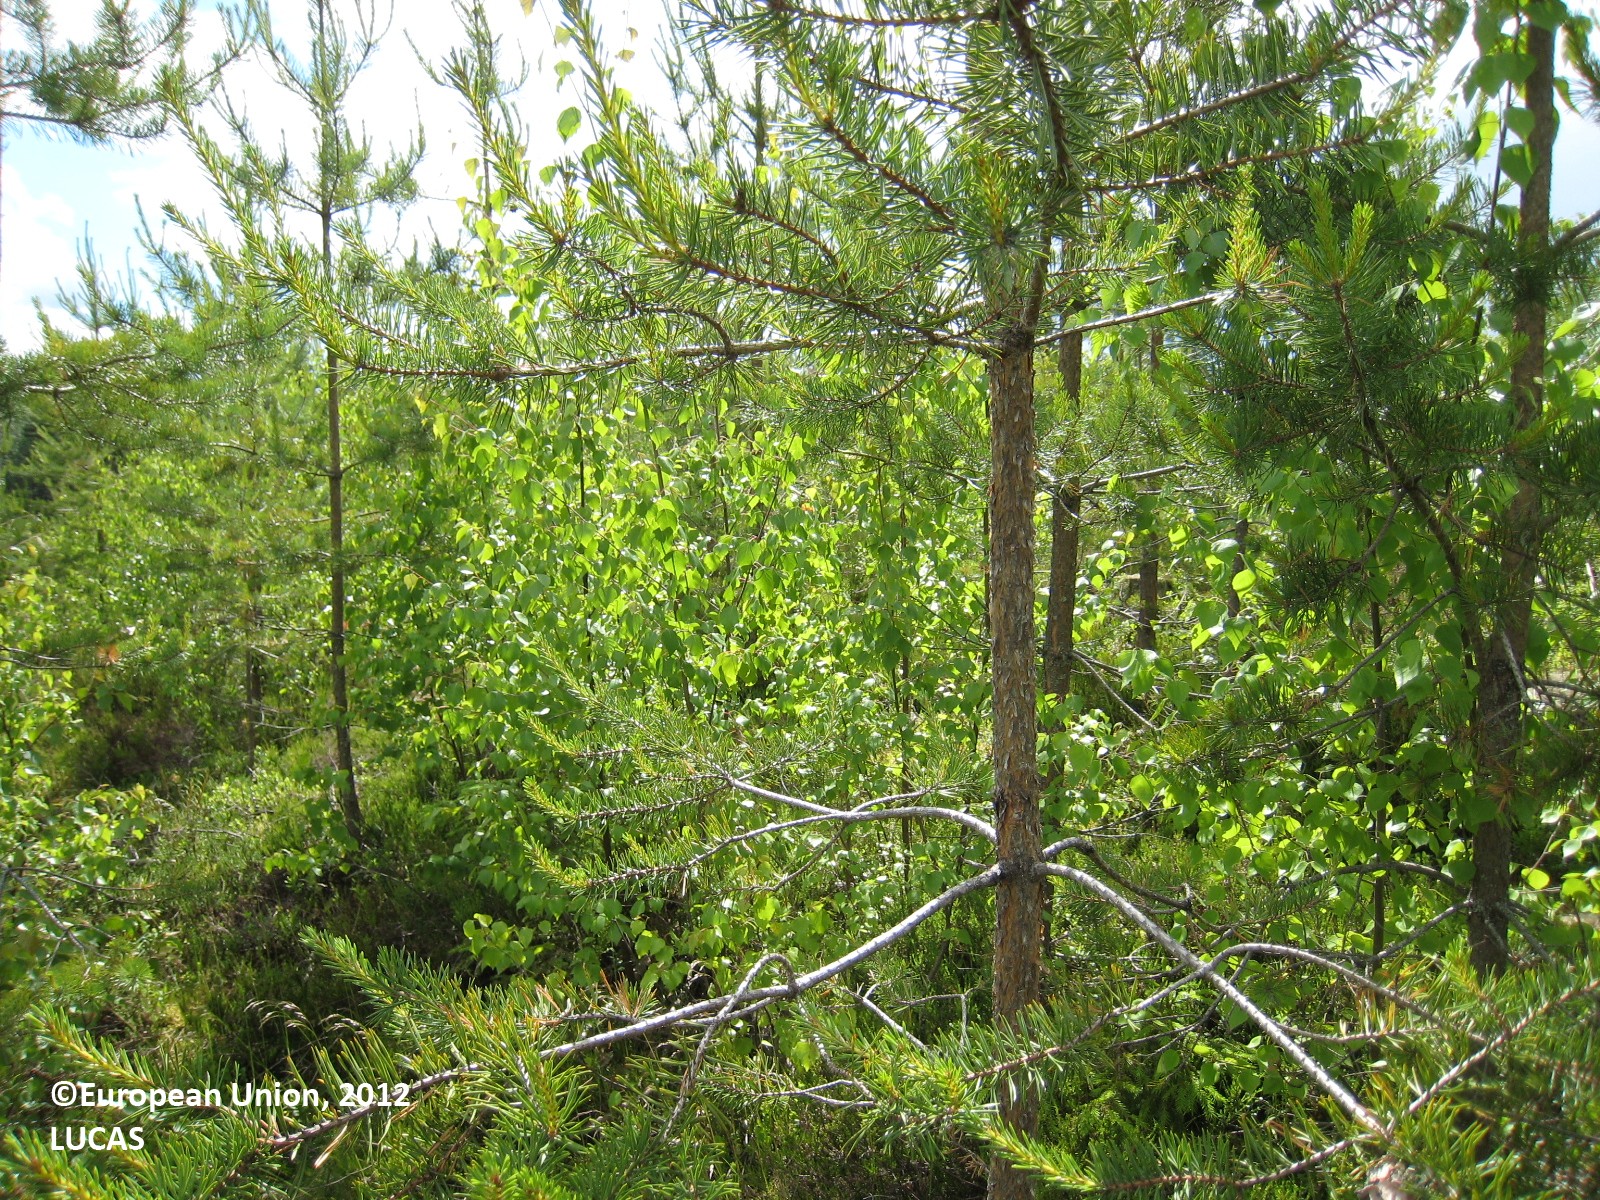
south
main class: Woodland
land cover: Pine dominated mixed woodland
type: boreal forest
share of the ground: 50 - 75 %
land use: Forestry
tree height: < 5 m
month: July
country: FI
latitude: 62.8351
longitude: 25.6818
